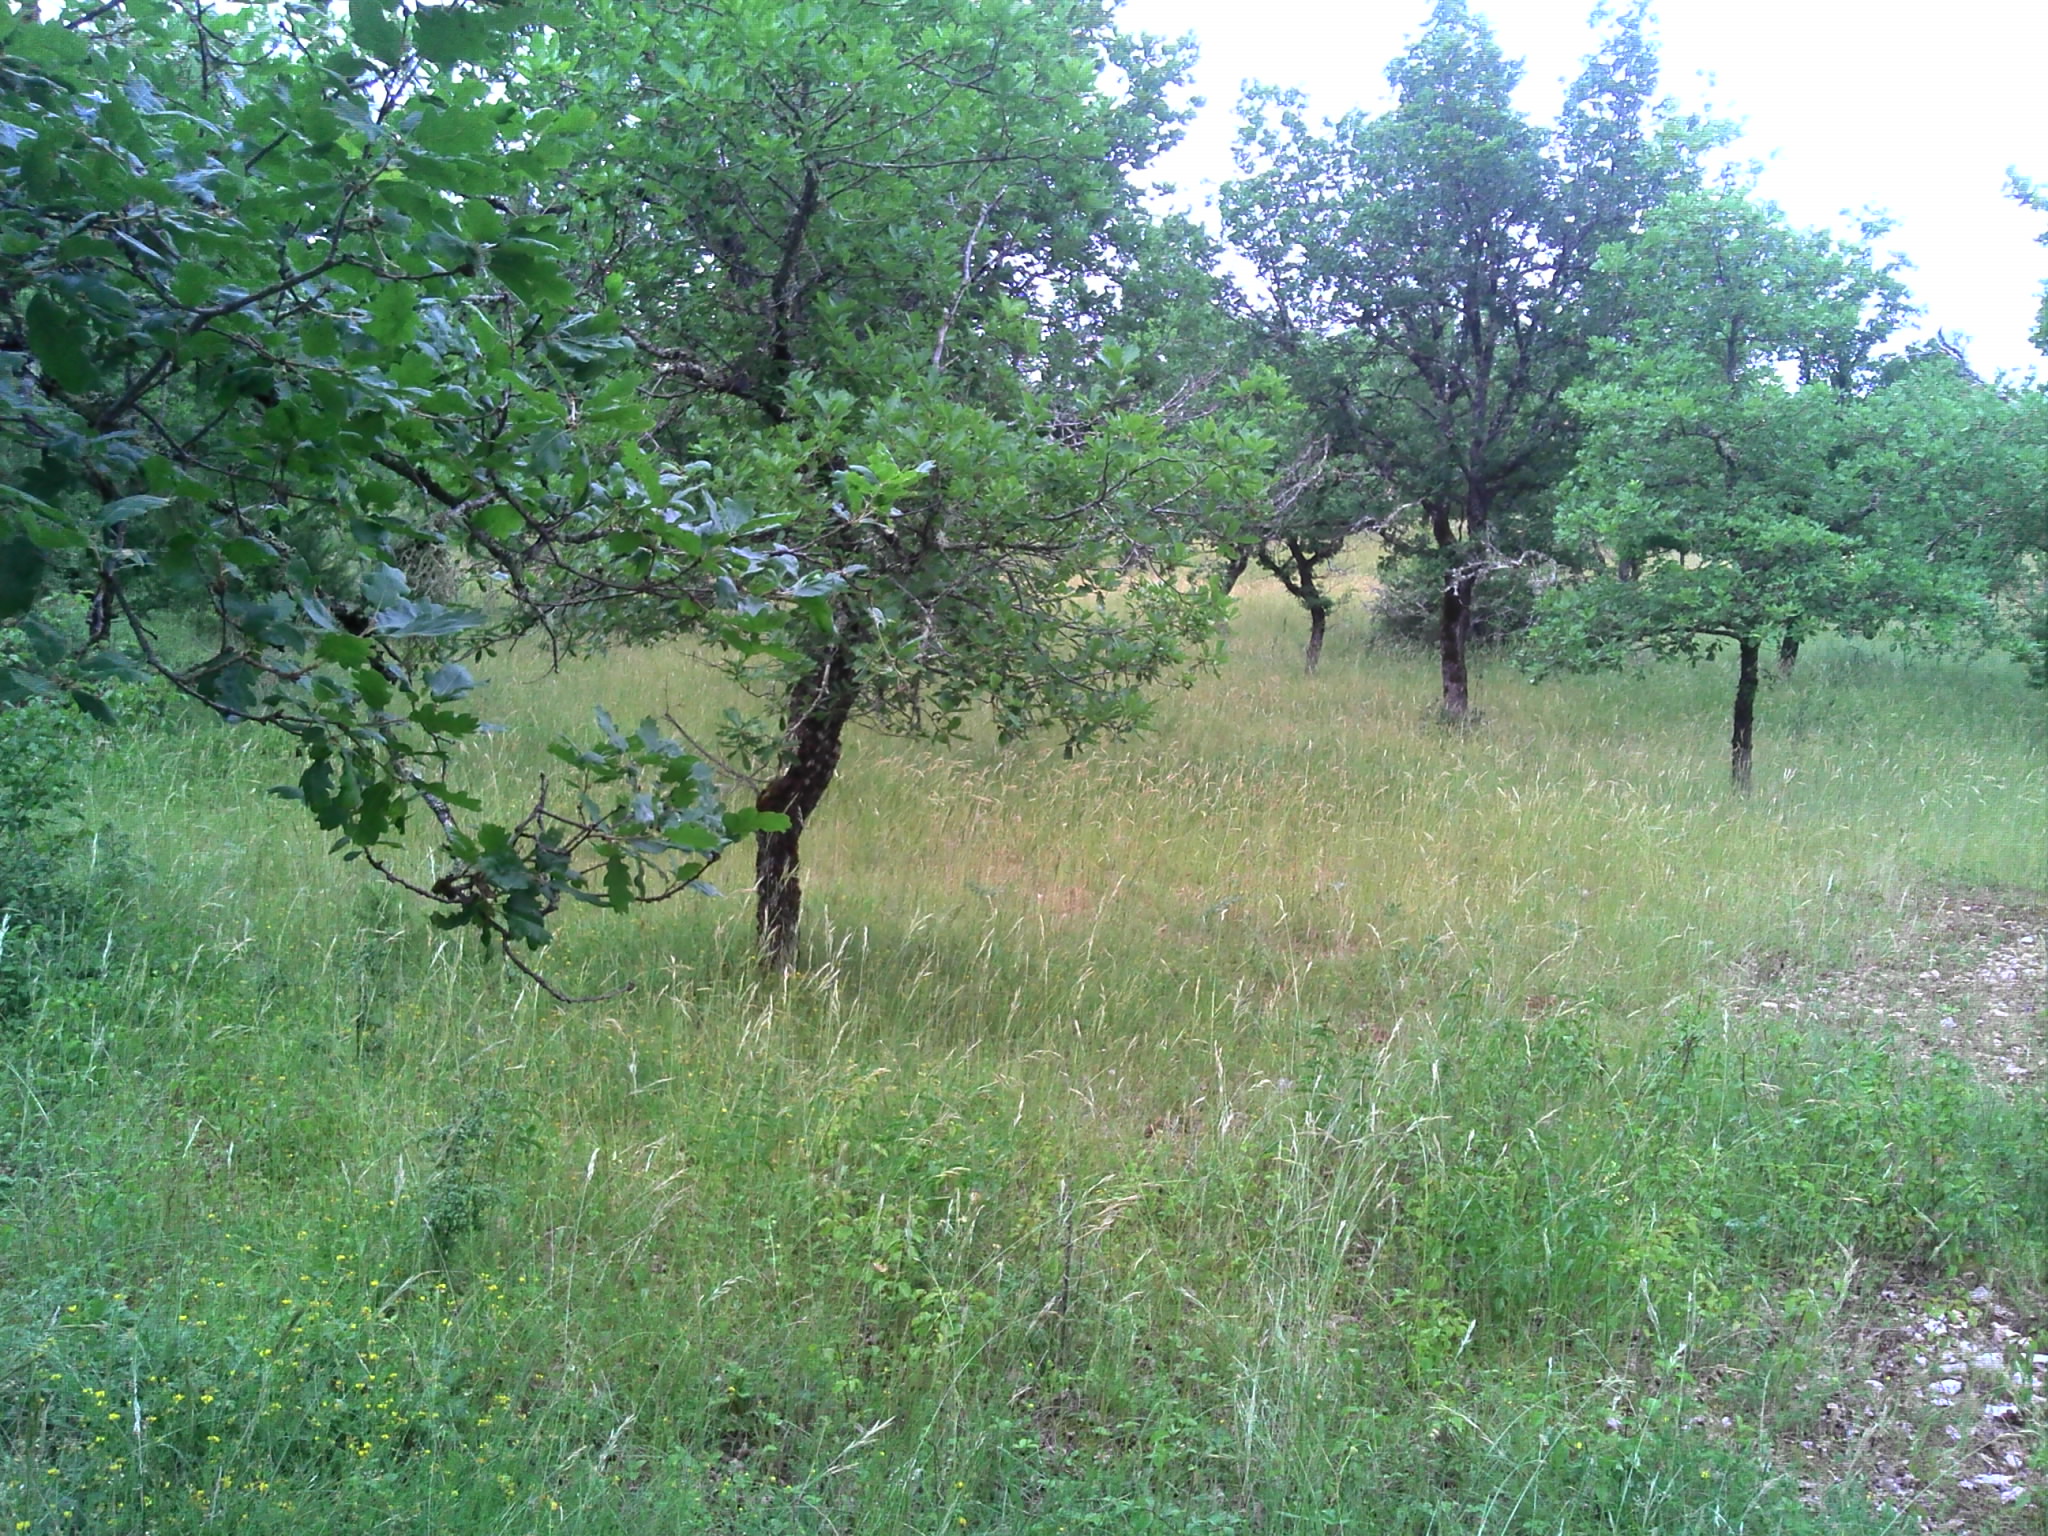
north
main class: Woodland
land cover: Broadleaved woodland
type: thermophilous deciduous forest
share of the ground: > 75 %
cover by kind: broadleaved forest trees 80 %, herbaceous plants 20 %
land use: Forestry
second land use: Agriculture (excluding fallow land and kitchen gardens)
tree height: < 5 m
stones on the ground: 25 - 50 %
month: June
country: FR
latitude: 44.4142
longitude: 1.6732
